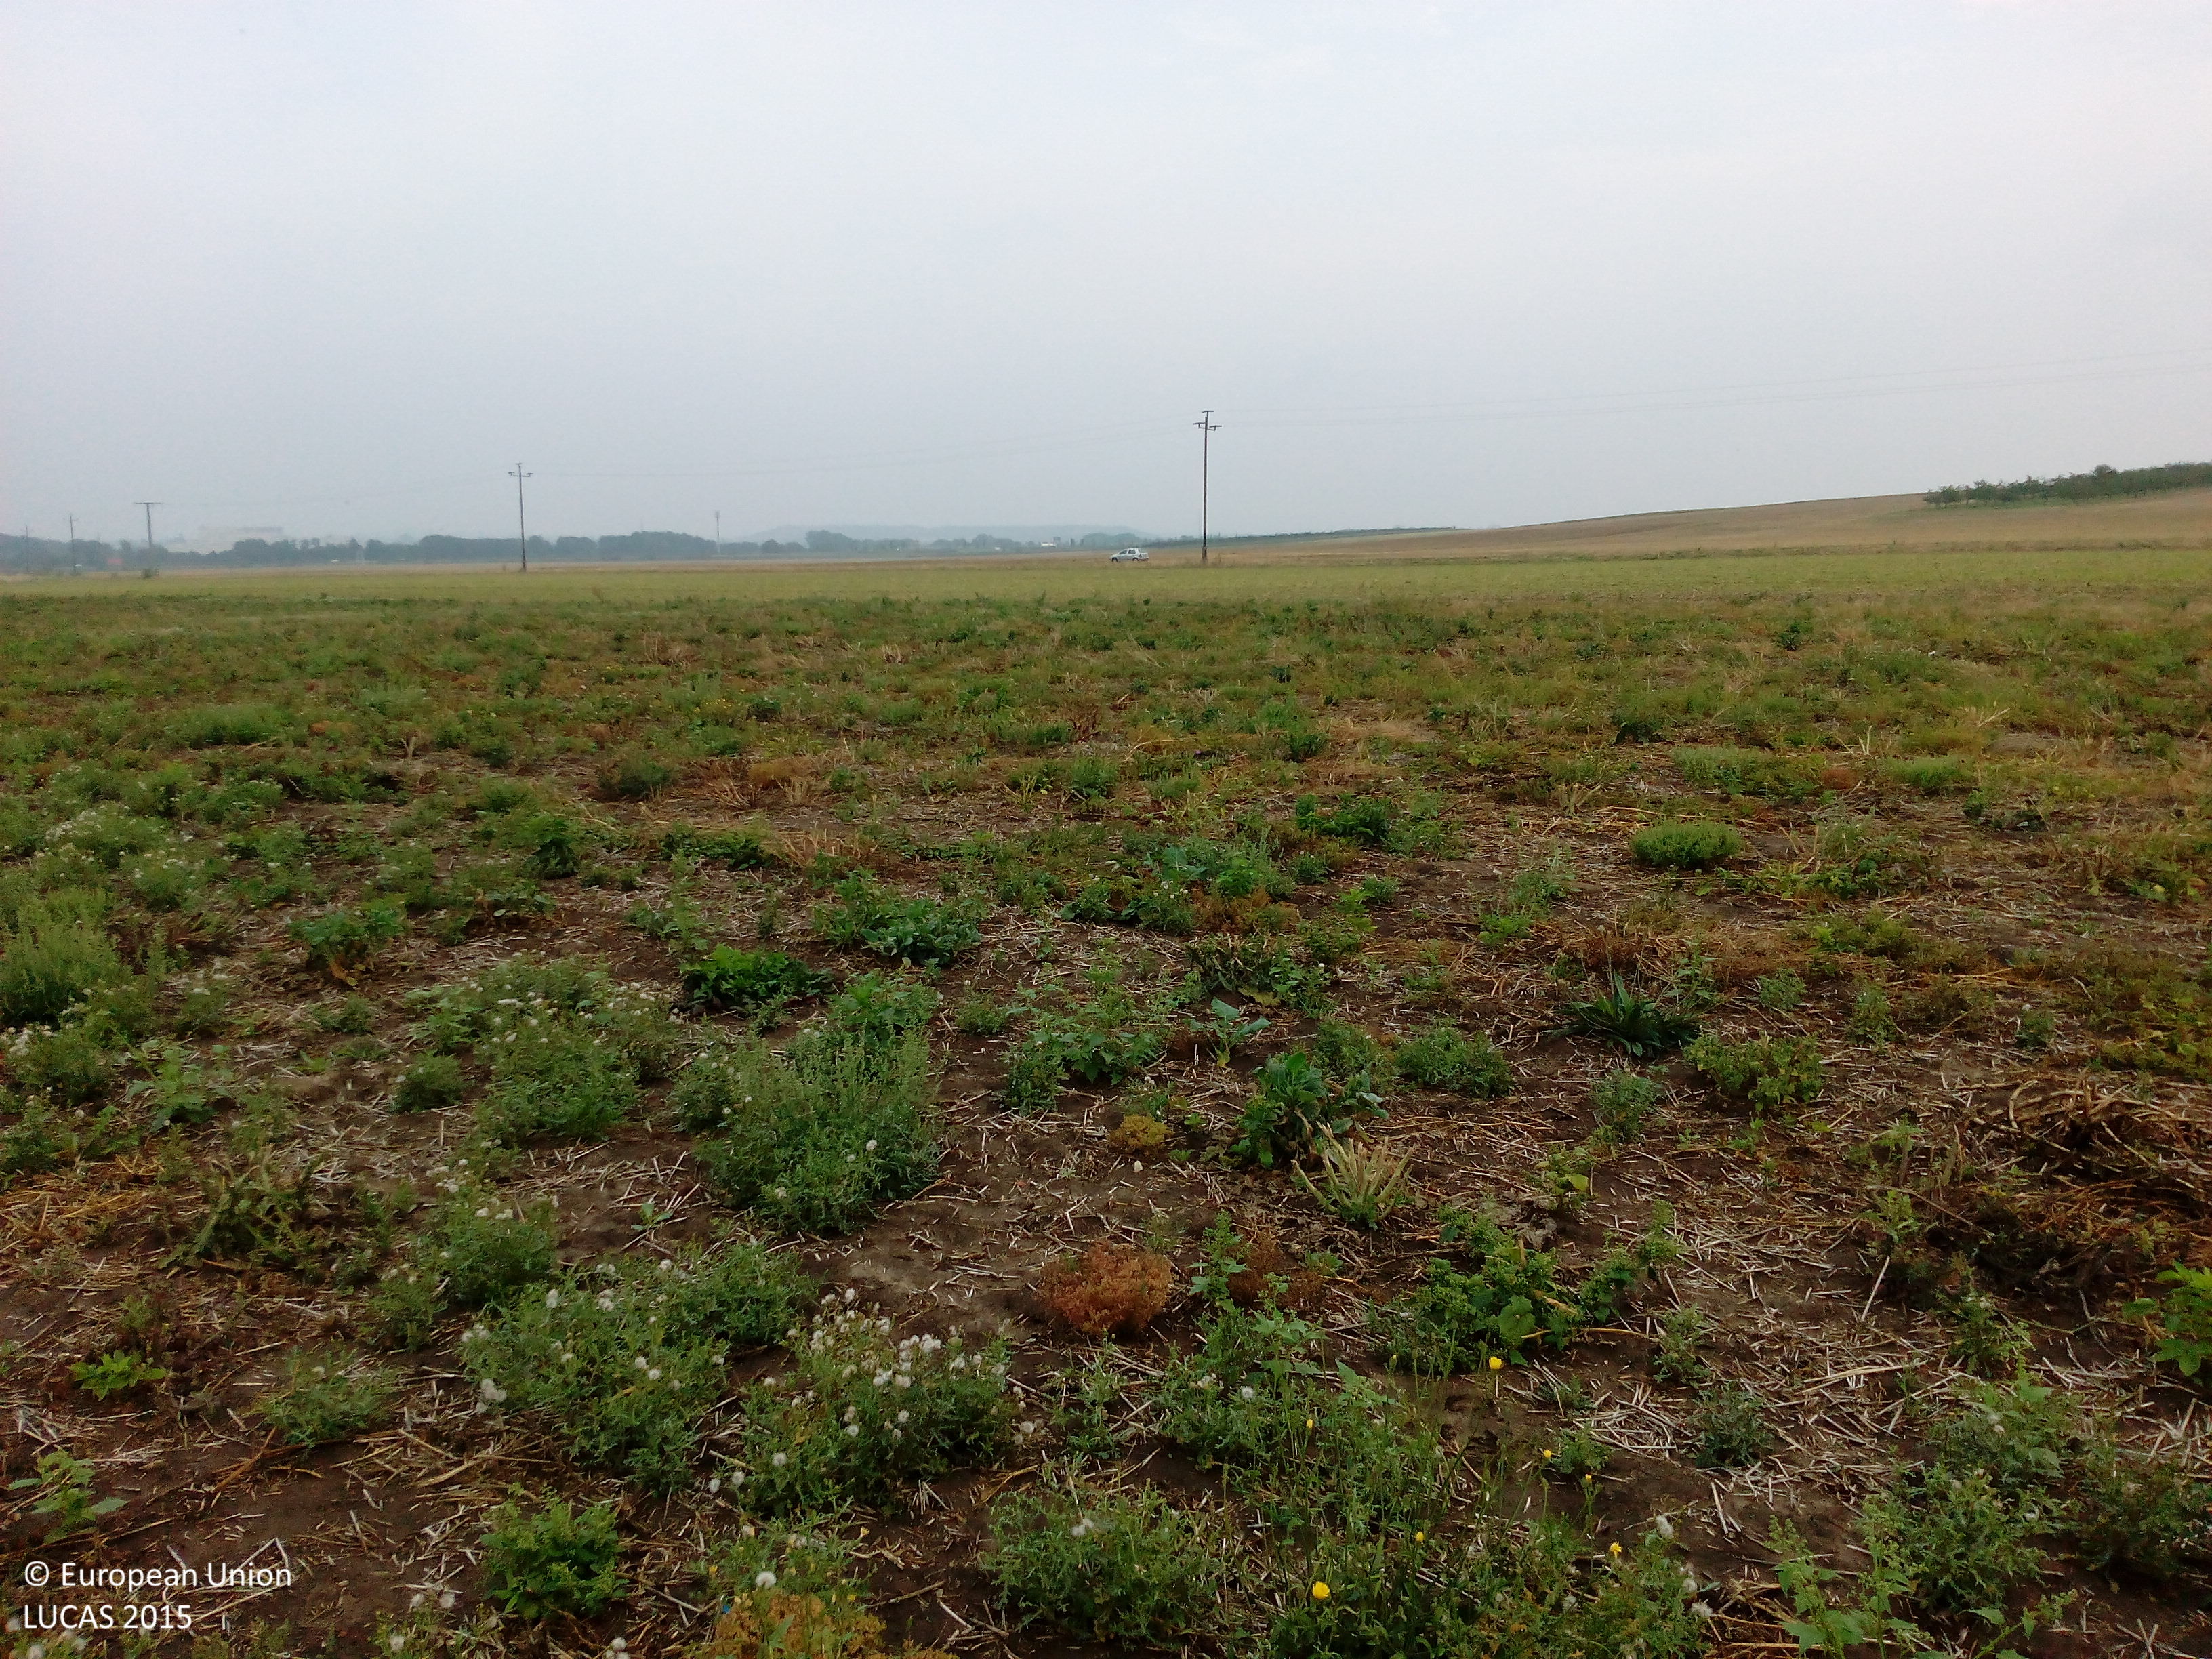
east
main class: Grassland
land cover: Spontaneously vegetated surfaces
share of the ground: 25 - 50 %
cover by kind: unconsolidated bare surface 60 %, herbaceous plants 40 %
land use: Fallow land
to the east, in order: Spontaneously vegetated surfaces; Barley; Grass margins; Electric lines; Grassland without tree/shrub cover; Tracks; Common wheat; Tracks; Common wheat
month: August
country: DE
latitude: 51.0254
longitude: 10.9550
